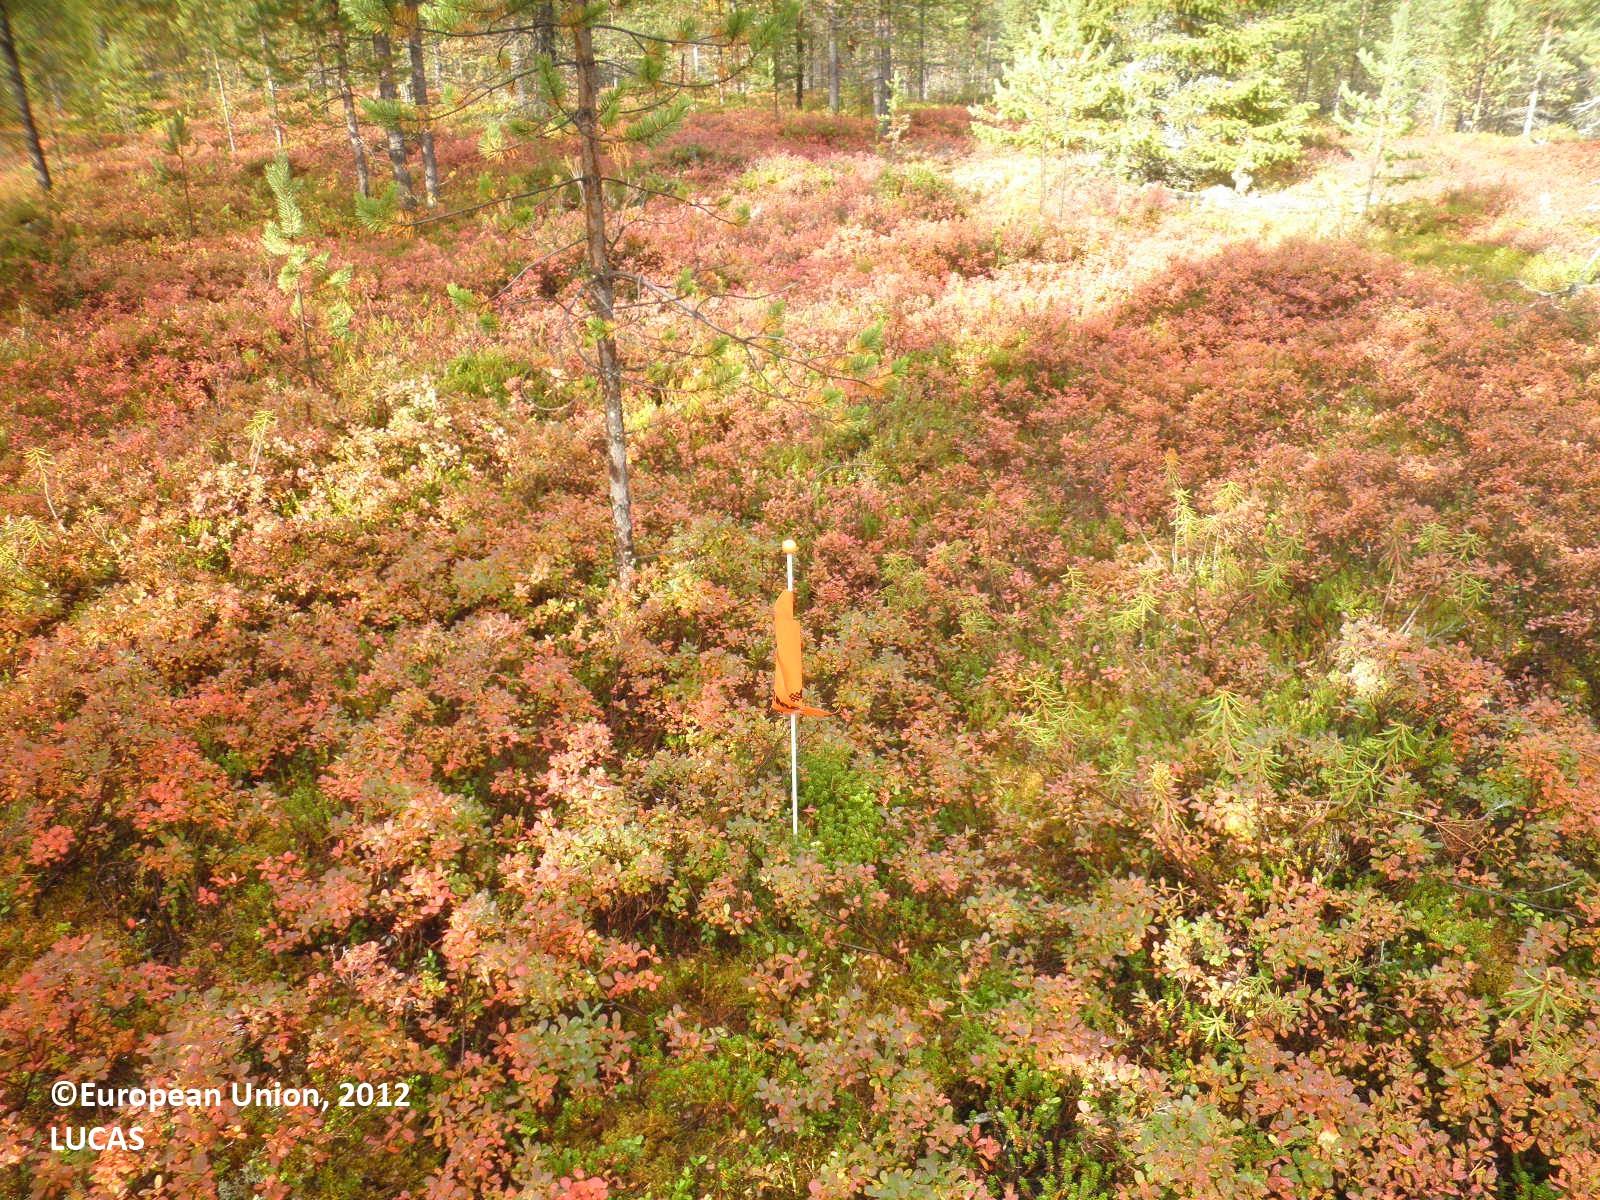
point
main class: Woodland
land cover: Pine dominated coniferous woodland
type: boreal forest
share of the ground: 25 - 50 %
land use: Forestry
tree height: > 5 m
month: September
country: FI
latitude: 67.6731
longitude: 28.6960
